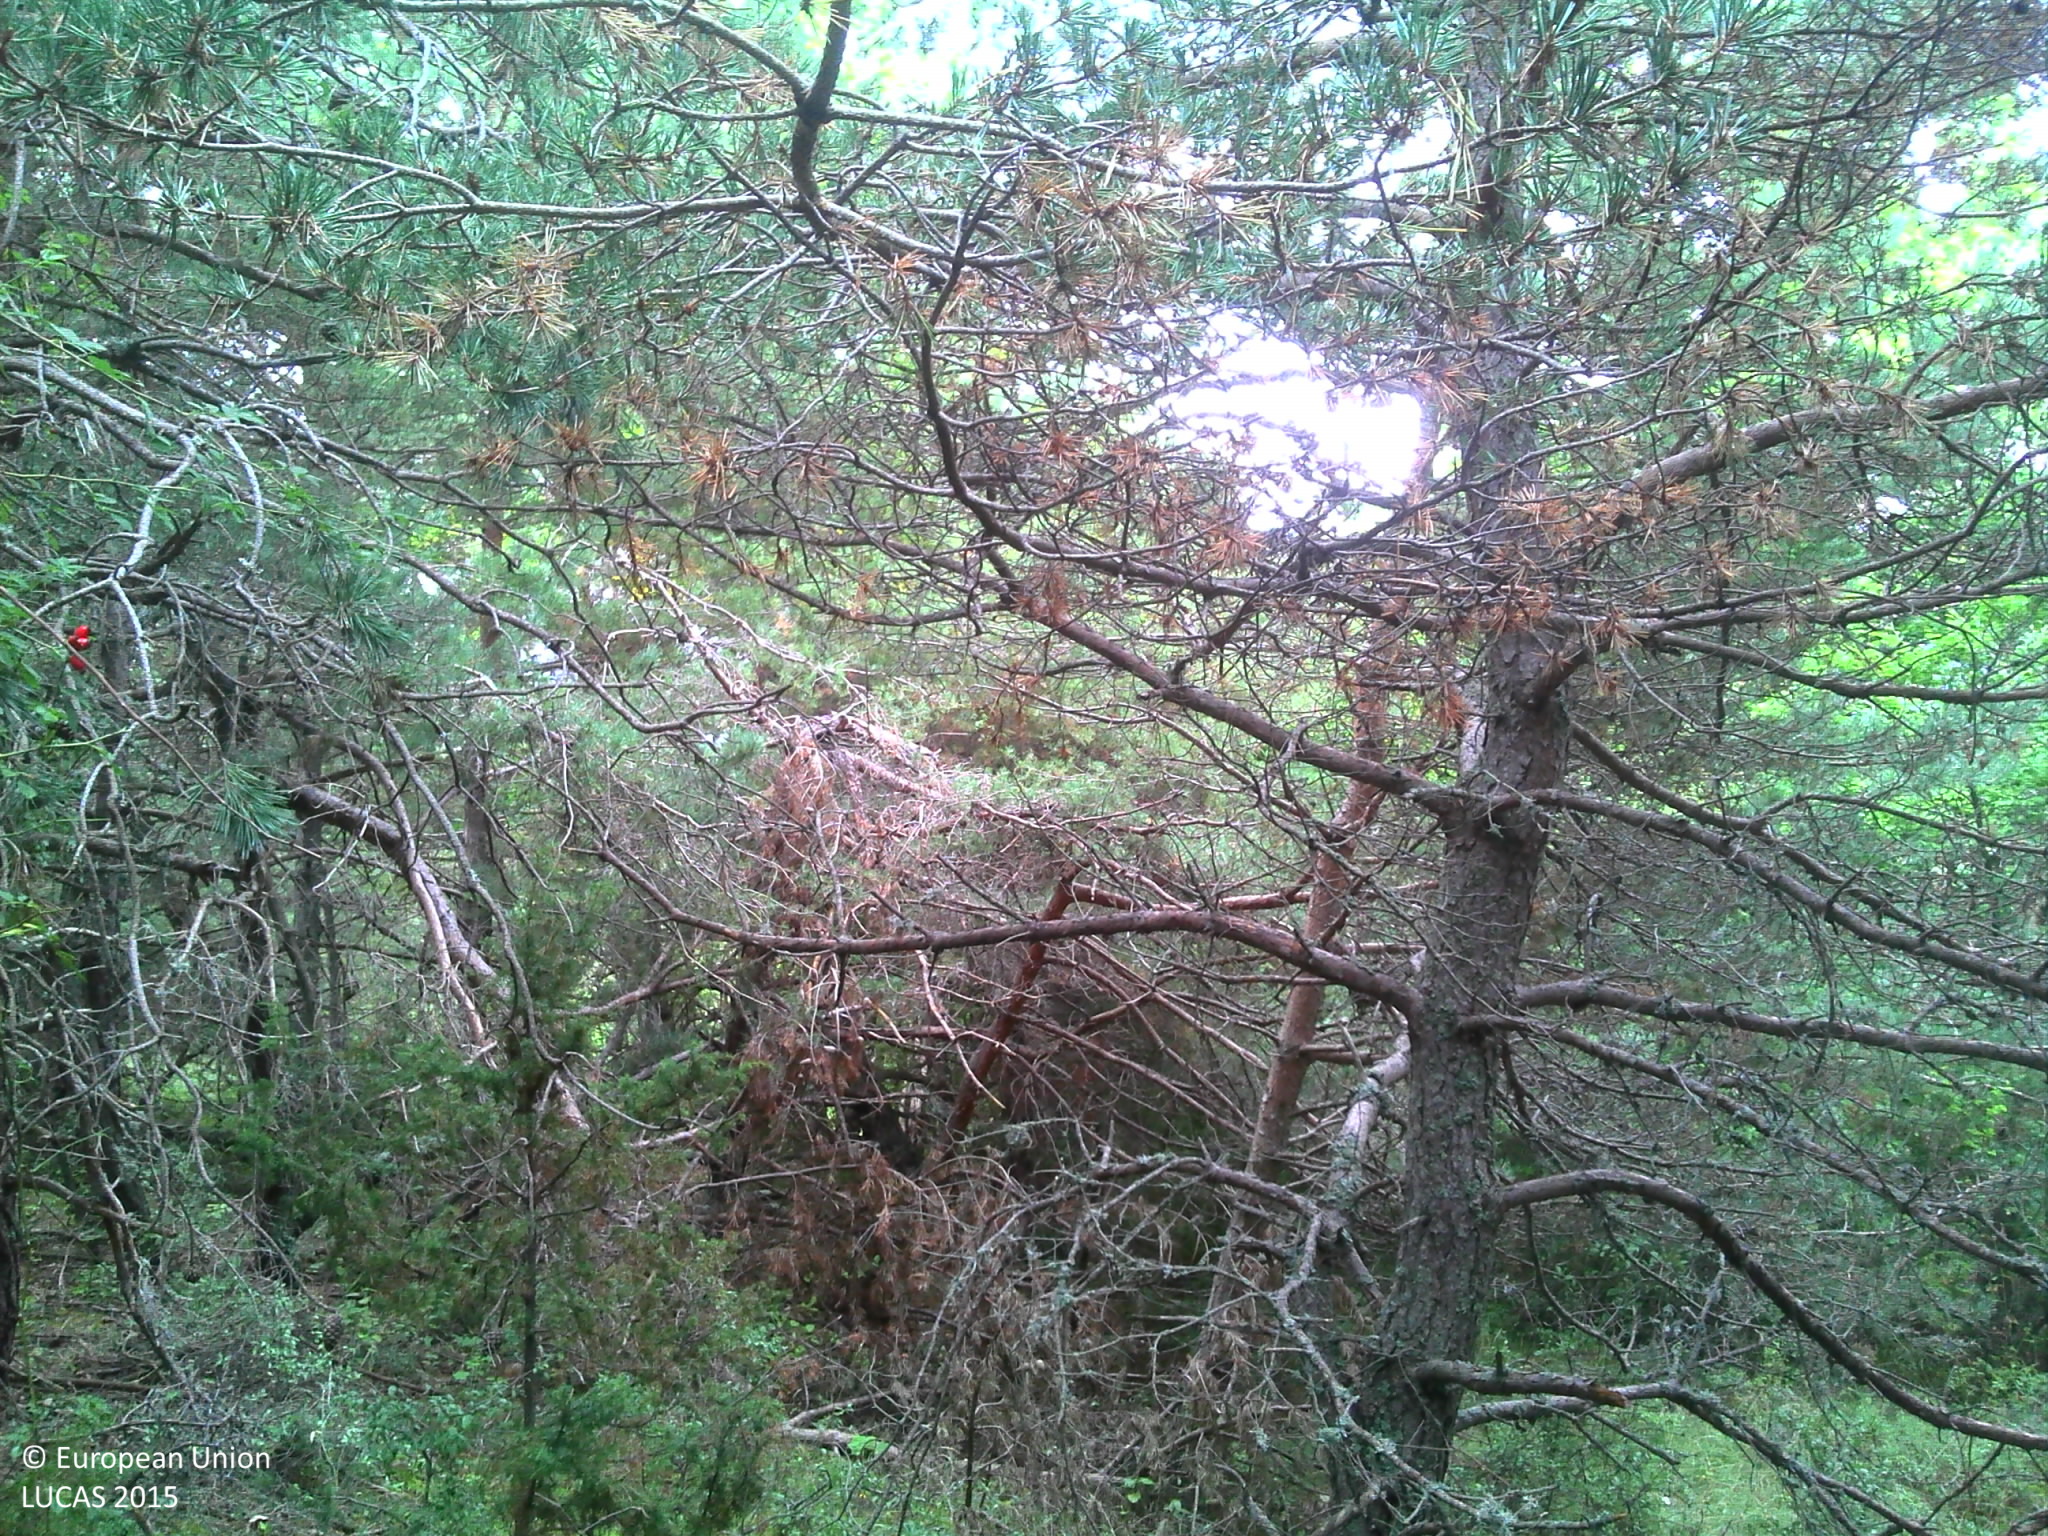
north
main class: Woodland
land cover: Pine dominated coniferous woodland
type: alpine coniferous forest
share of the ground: > 75 %
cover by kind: coniferous forest trees 90 %, broadleaved forest trees 5 %, herbaceous plants 5 %
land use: Forestry
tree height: > 5 m
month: September
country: FR
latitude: 44.5337
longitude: 5.3130
